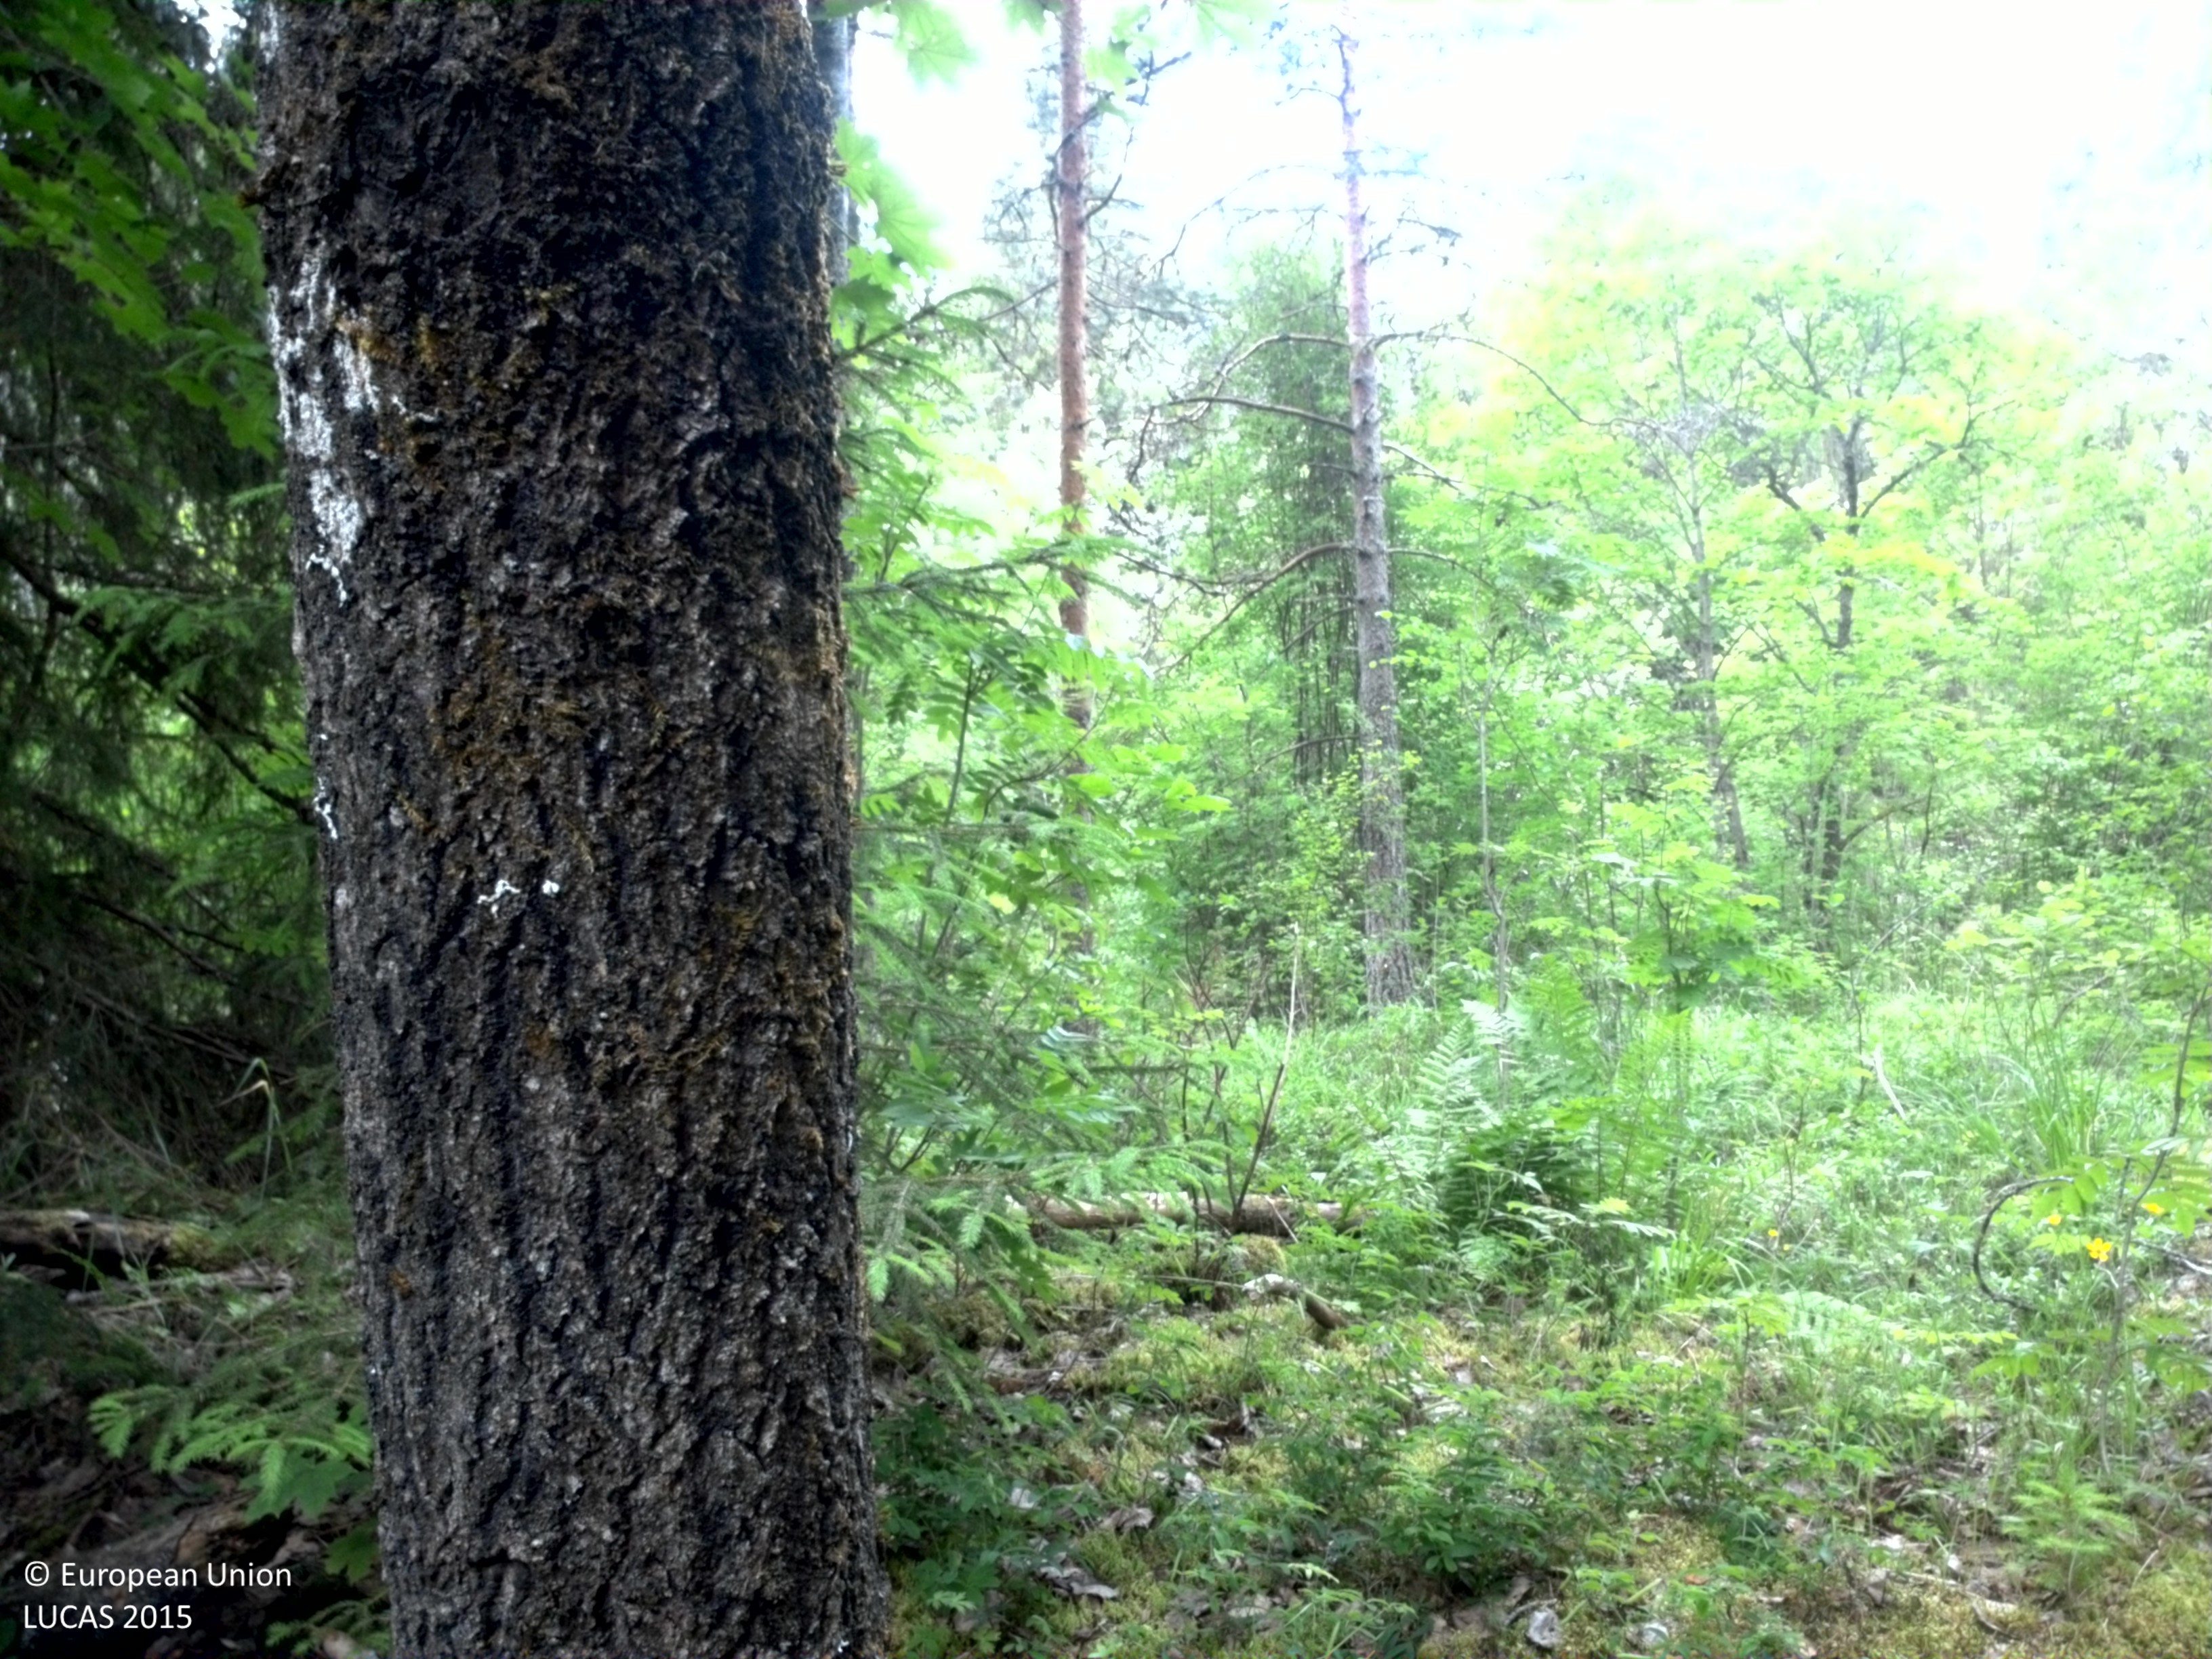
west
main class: Woodland
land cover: Broadleaved woodland
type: boreal forest
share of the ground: 25 - 50 %
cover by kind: herbaceous plants 45 %, broadleaved forest trees 35 %, shrubs 10 %, coniferous forest trees 5 %, lichens and mosses 5 %
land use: Semi-natural and natural areas not in use
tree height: > 5 m
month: June
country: SE
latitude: 59.7653
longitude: 12.3260
